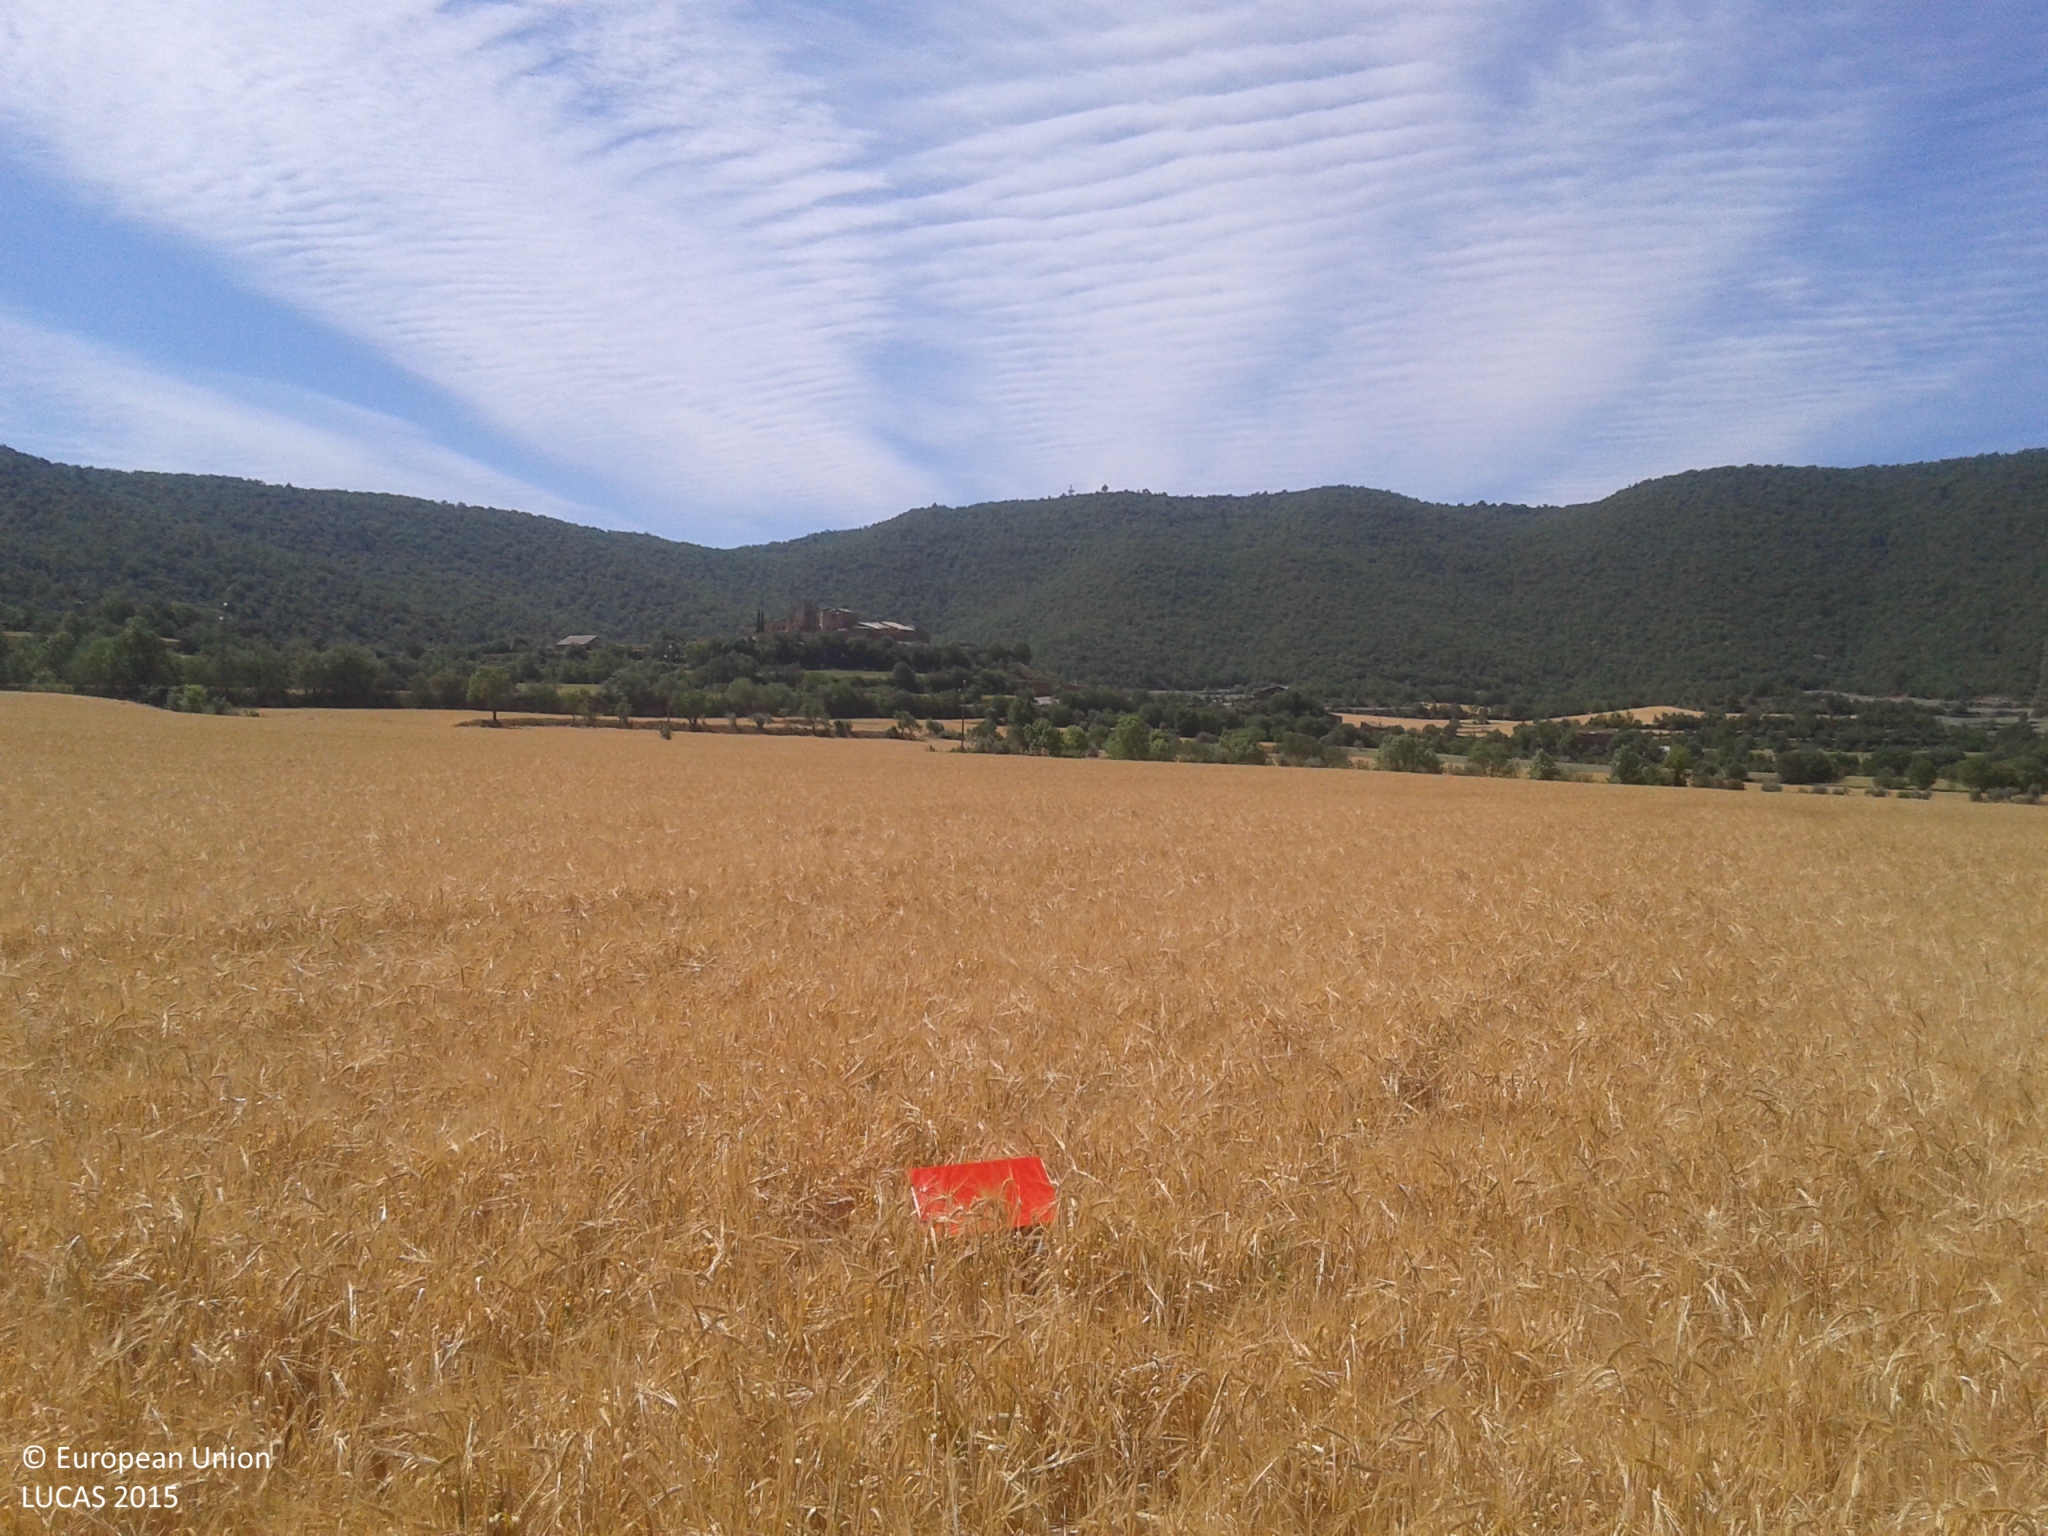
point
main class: Cropland
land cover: Rye
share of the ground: > 75 %
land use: Agriculture (excluding fallow land and kitchen gardens)
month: May
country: ES
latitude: 41.9209
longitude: 1.1492
